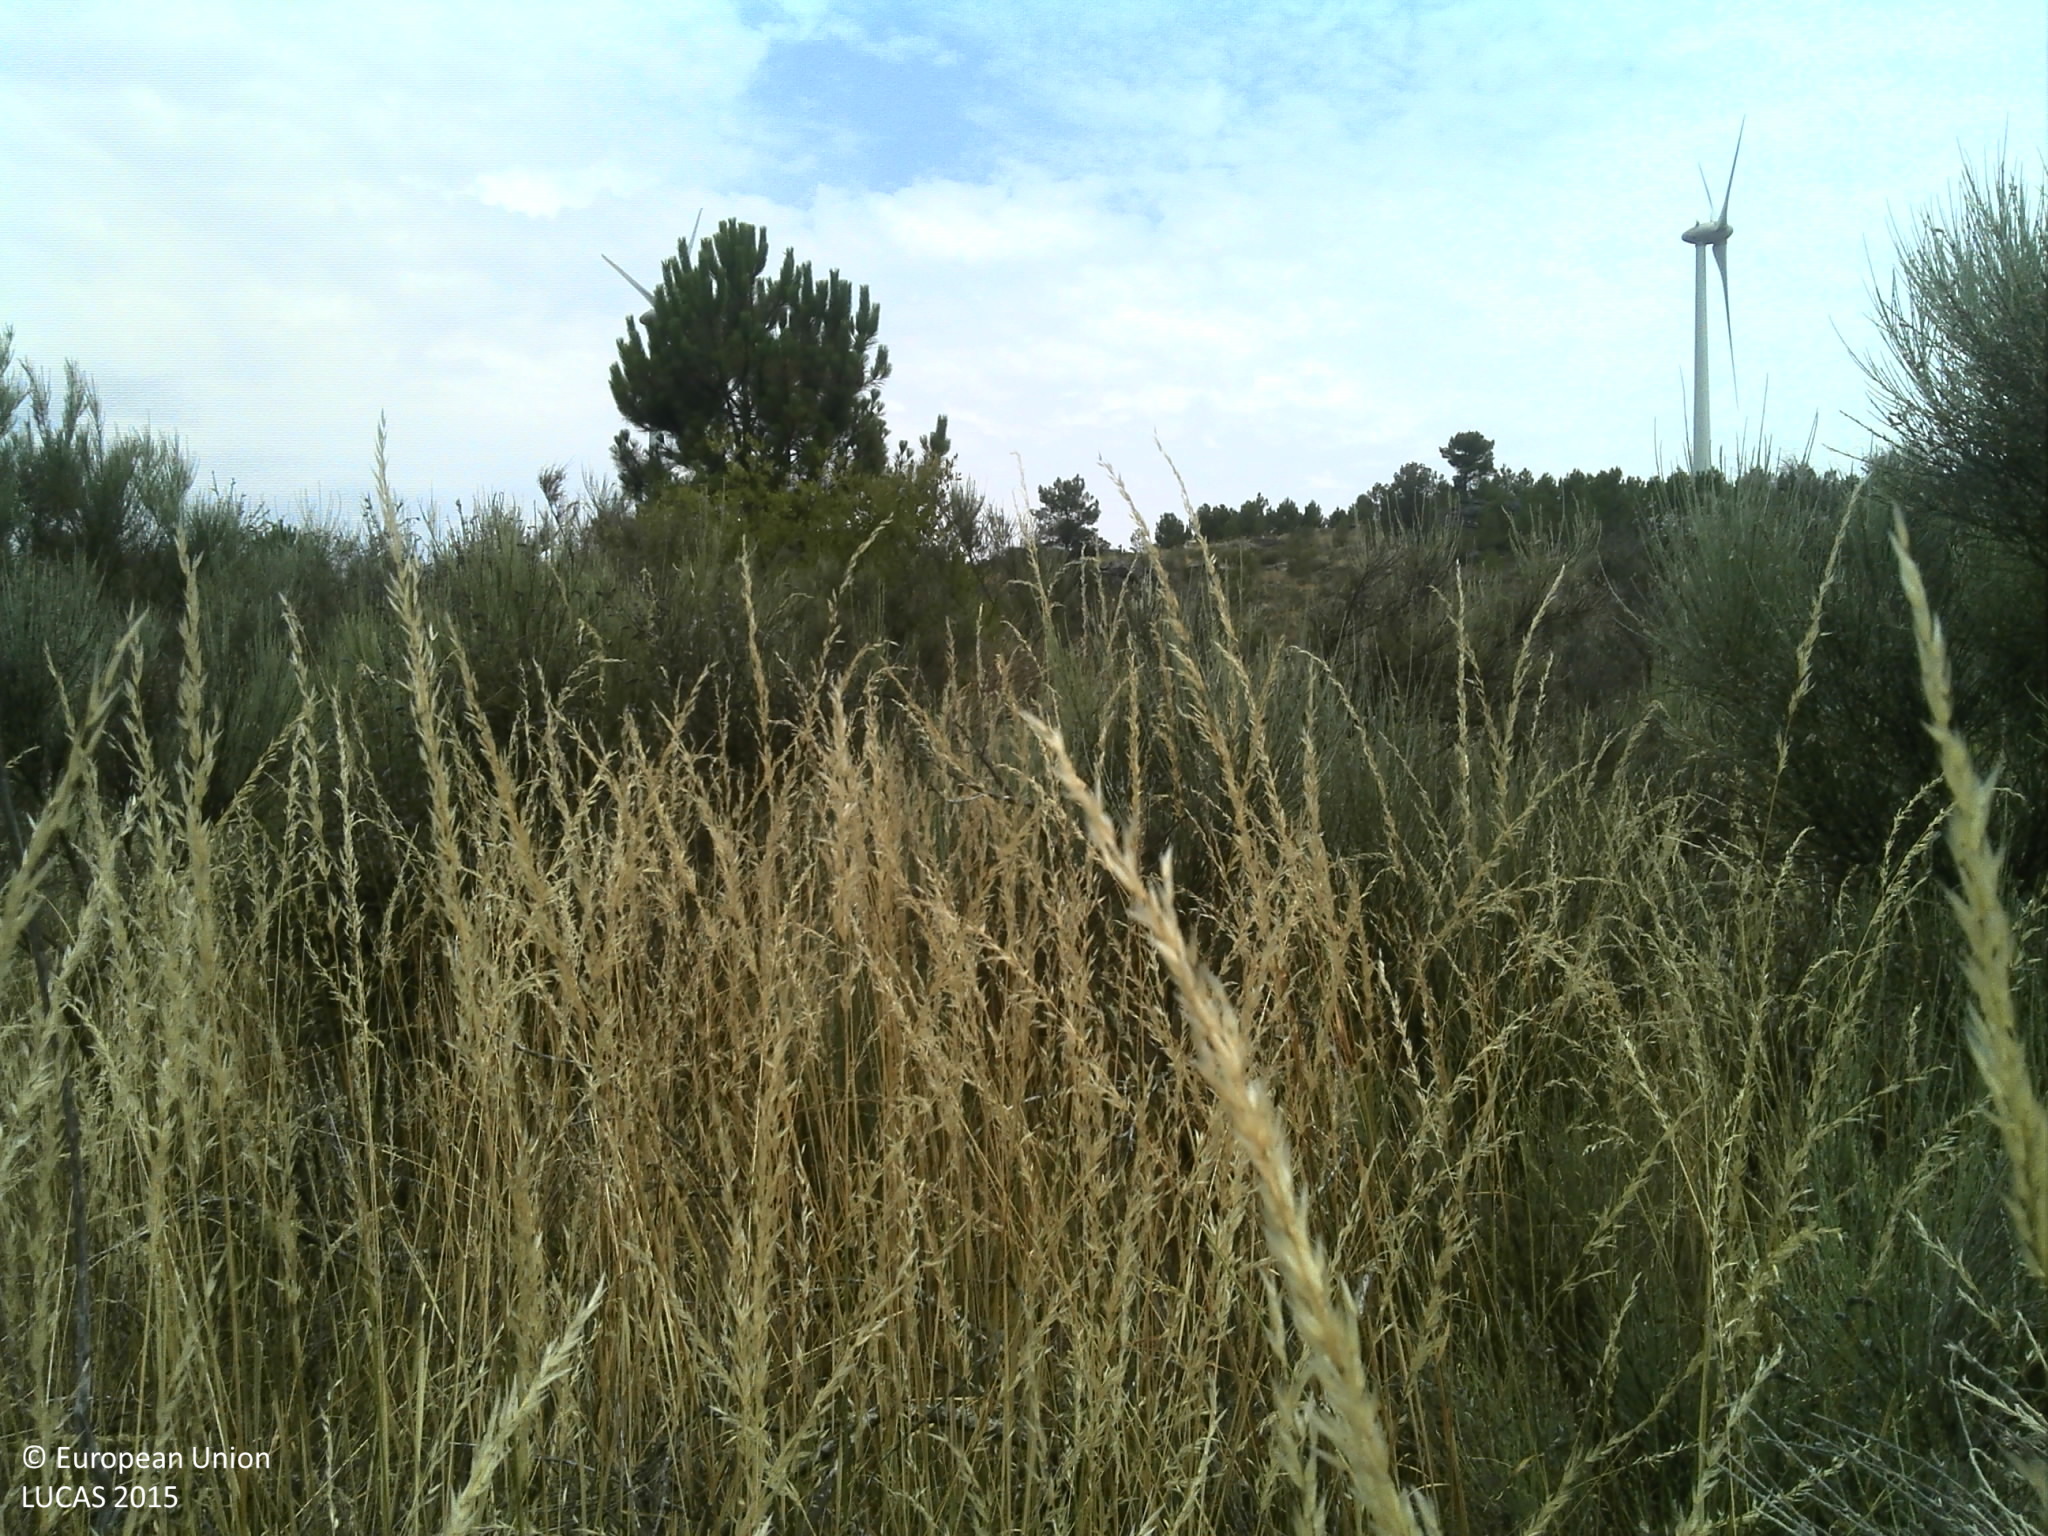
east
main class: Shrubland
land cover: Shrubland with sparse tree cover
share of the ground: 50 - 75 %
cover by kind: shrubs 65 %, herbaceous plants 15 %, unconsolidated bare surface 10 %, coniferous forest trees 5 %, consolidated bare surface 5 %
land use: Semi-natural and natural areas not in use
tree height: > 5 m
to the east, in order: Shrubland with sparse tree cover; Shrubland without tree cover; Dry stone walls; Shrubland without tree cover; Shrubland with sparse tree cover; Rock outcrops; Pine dominated coniferous woodland
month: July
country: PT
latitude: 41.0107
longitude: -7.3691
